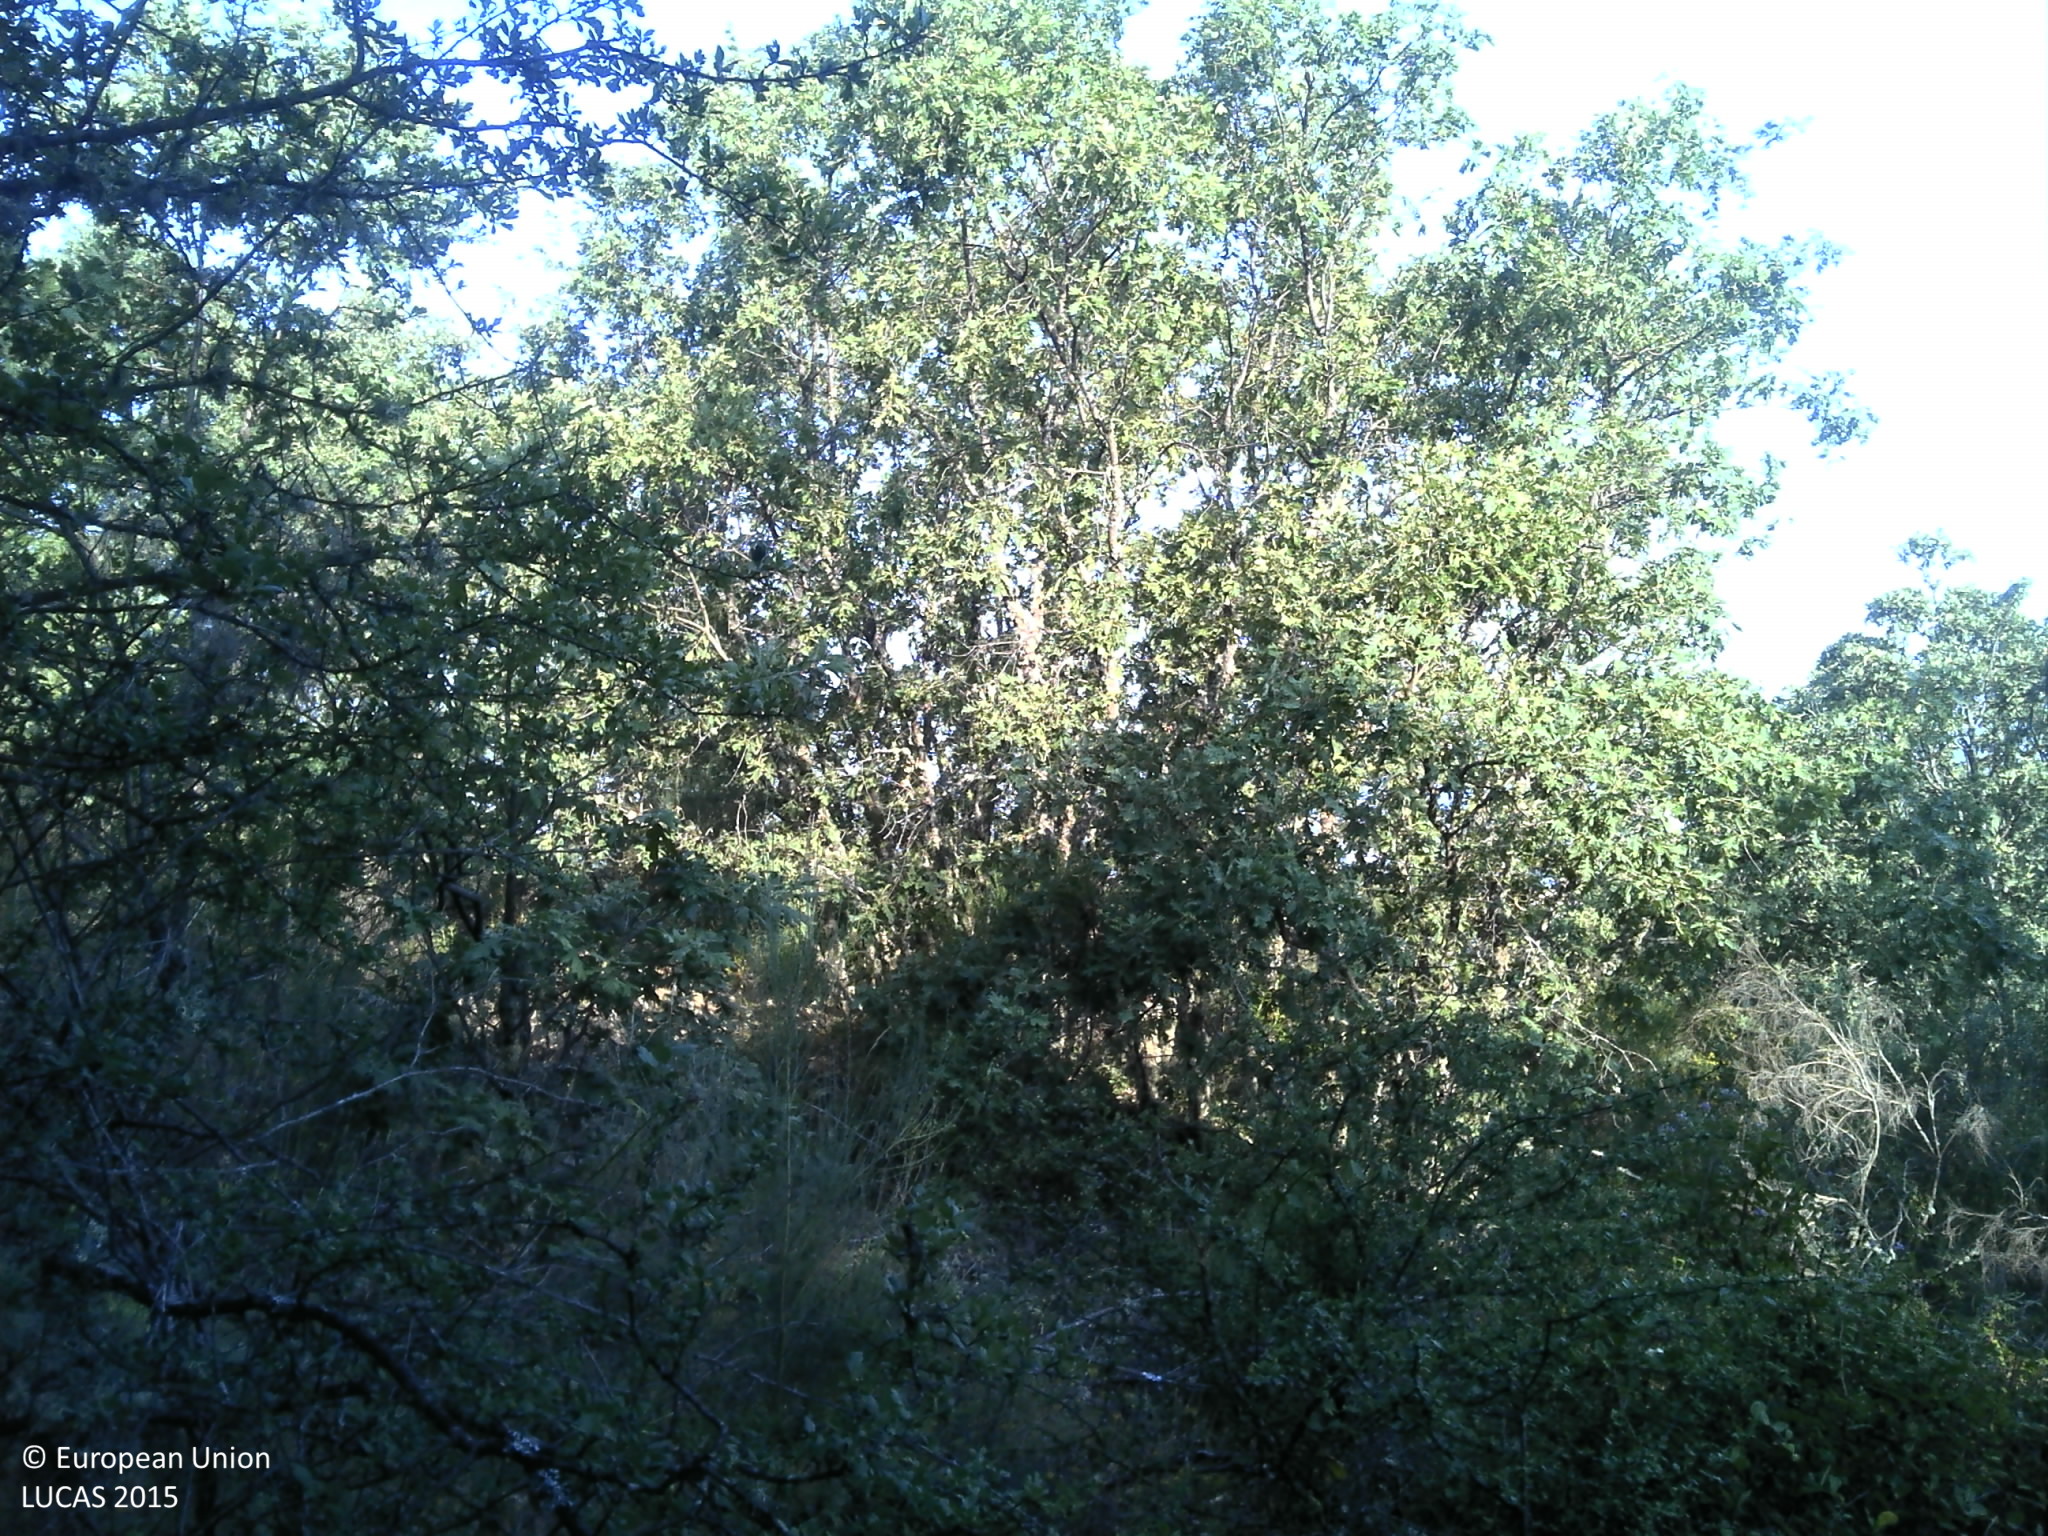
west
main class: Woodland
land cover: Broadleaved woodland
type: acidophilous oak and oak-birch forest
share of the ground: 50 - 75 %
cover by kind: broadleaved forest trees 65 %, shrubs 25 %, unconsolidated bare surface 5 %
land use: Forestry
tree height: > 5 m
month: June
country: PT
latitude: 40.2320
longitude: -7.3926
